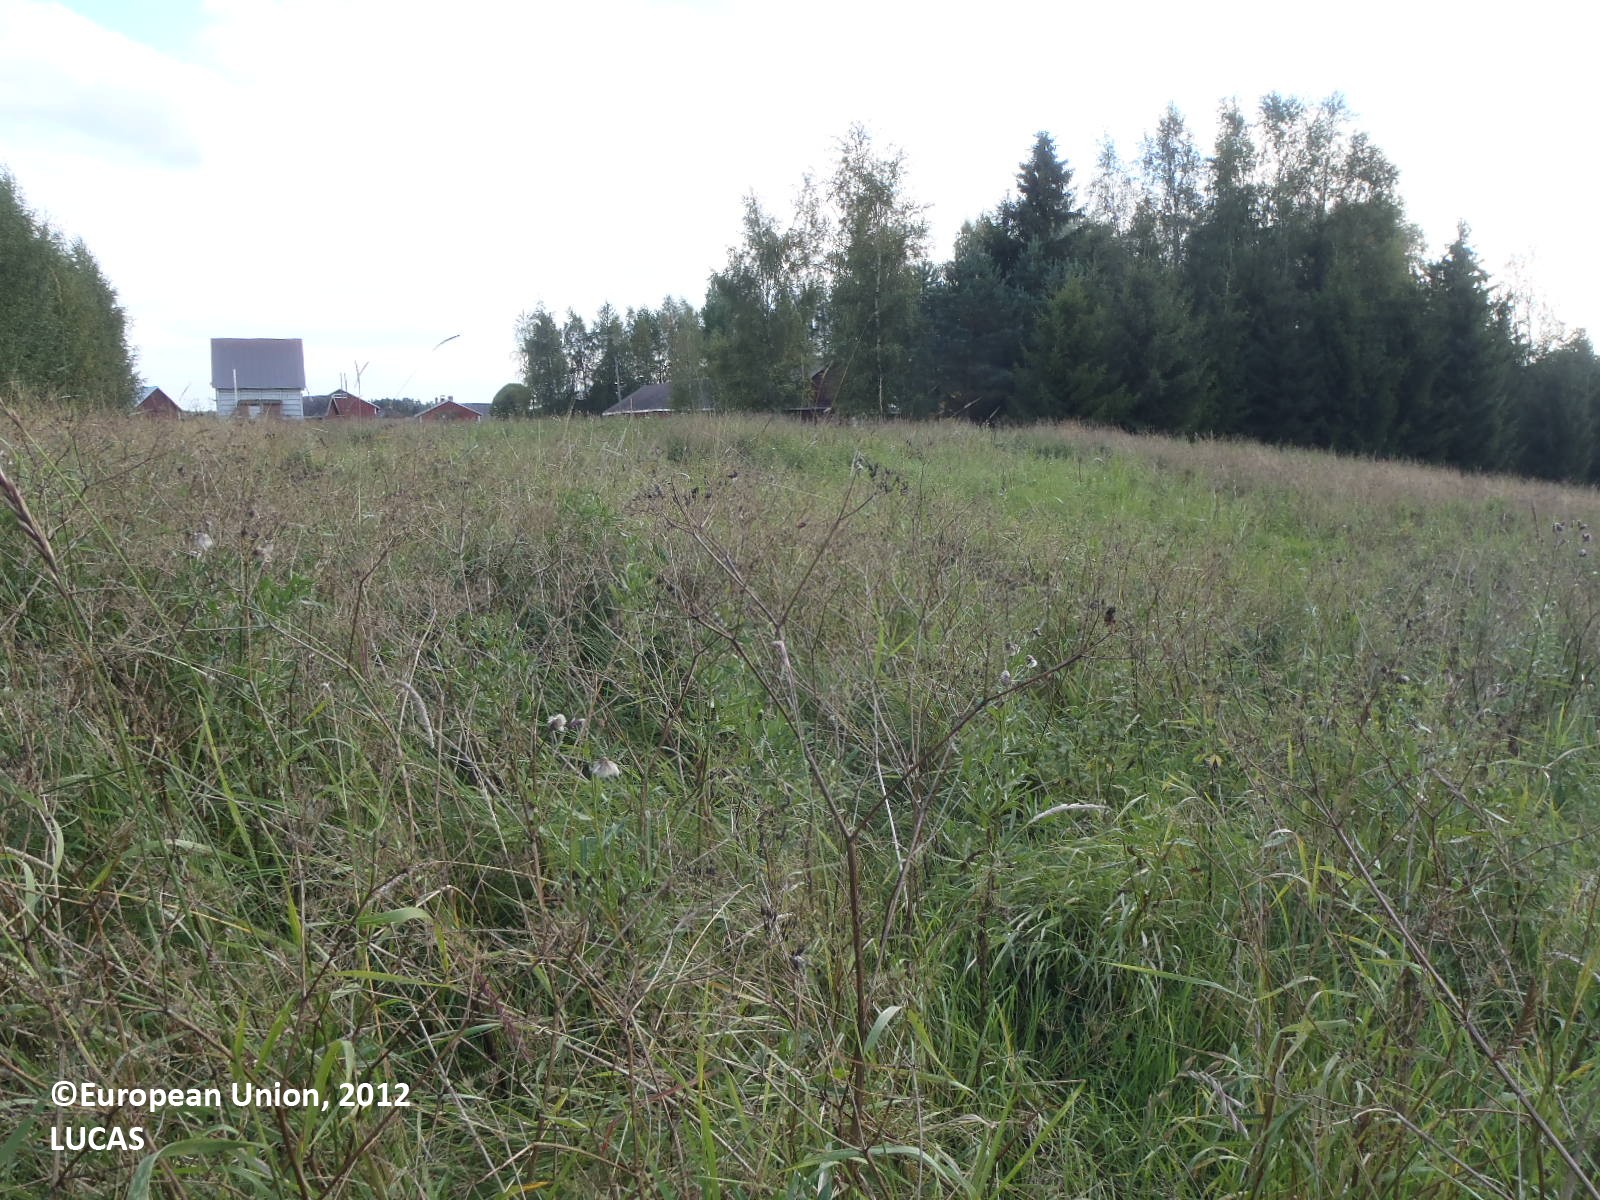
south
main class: Grassland
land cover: Grassland without tree/shrub cover
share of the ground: > 75 %
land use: Fallow land
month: August
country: FI
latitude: 60.6203
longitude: 22.7735
